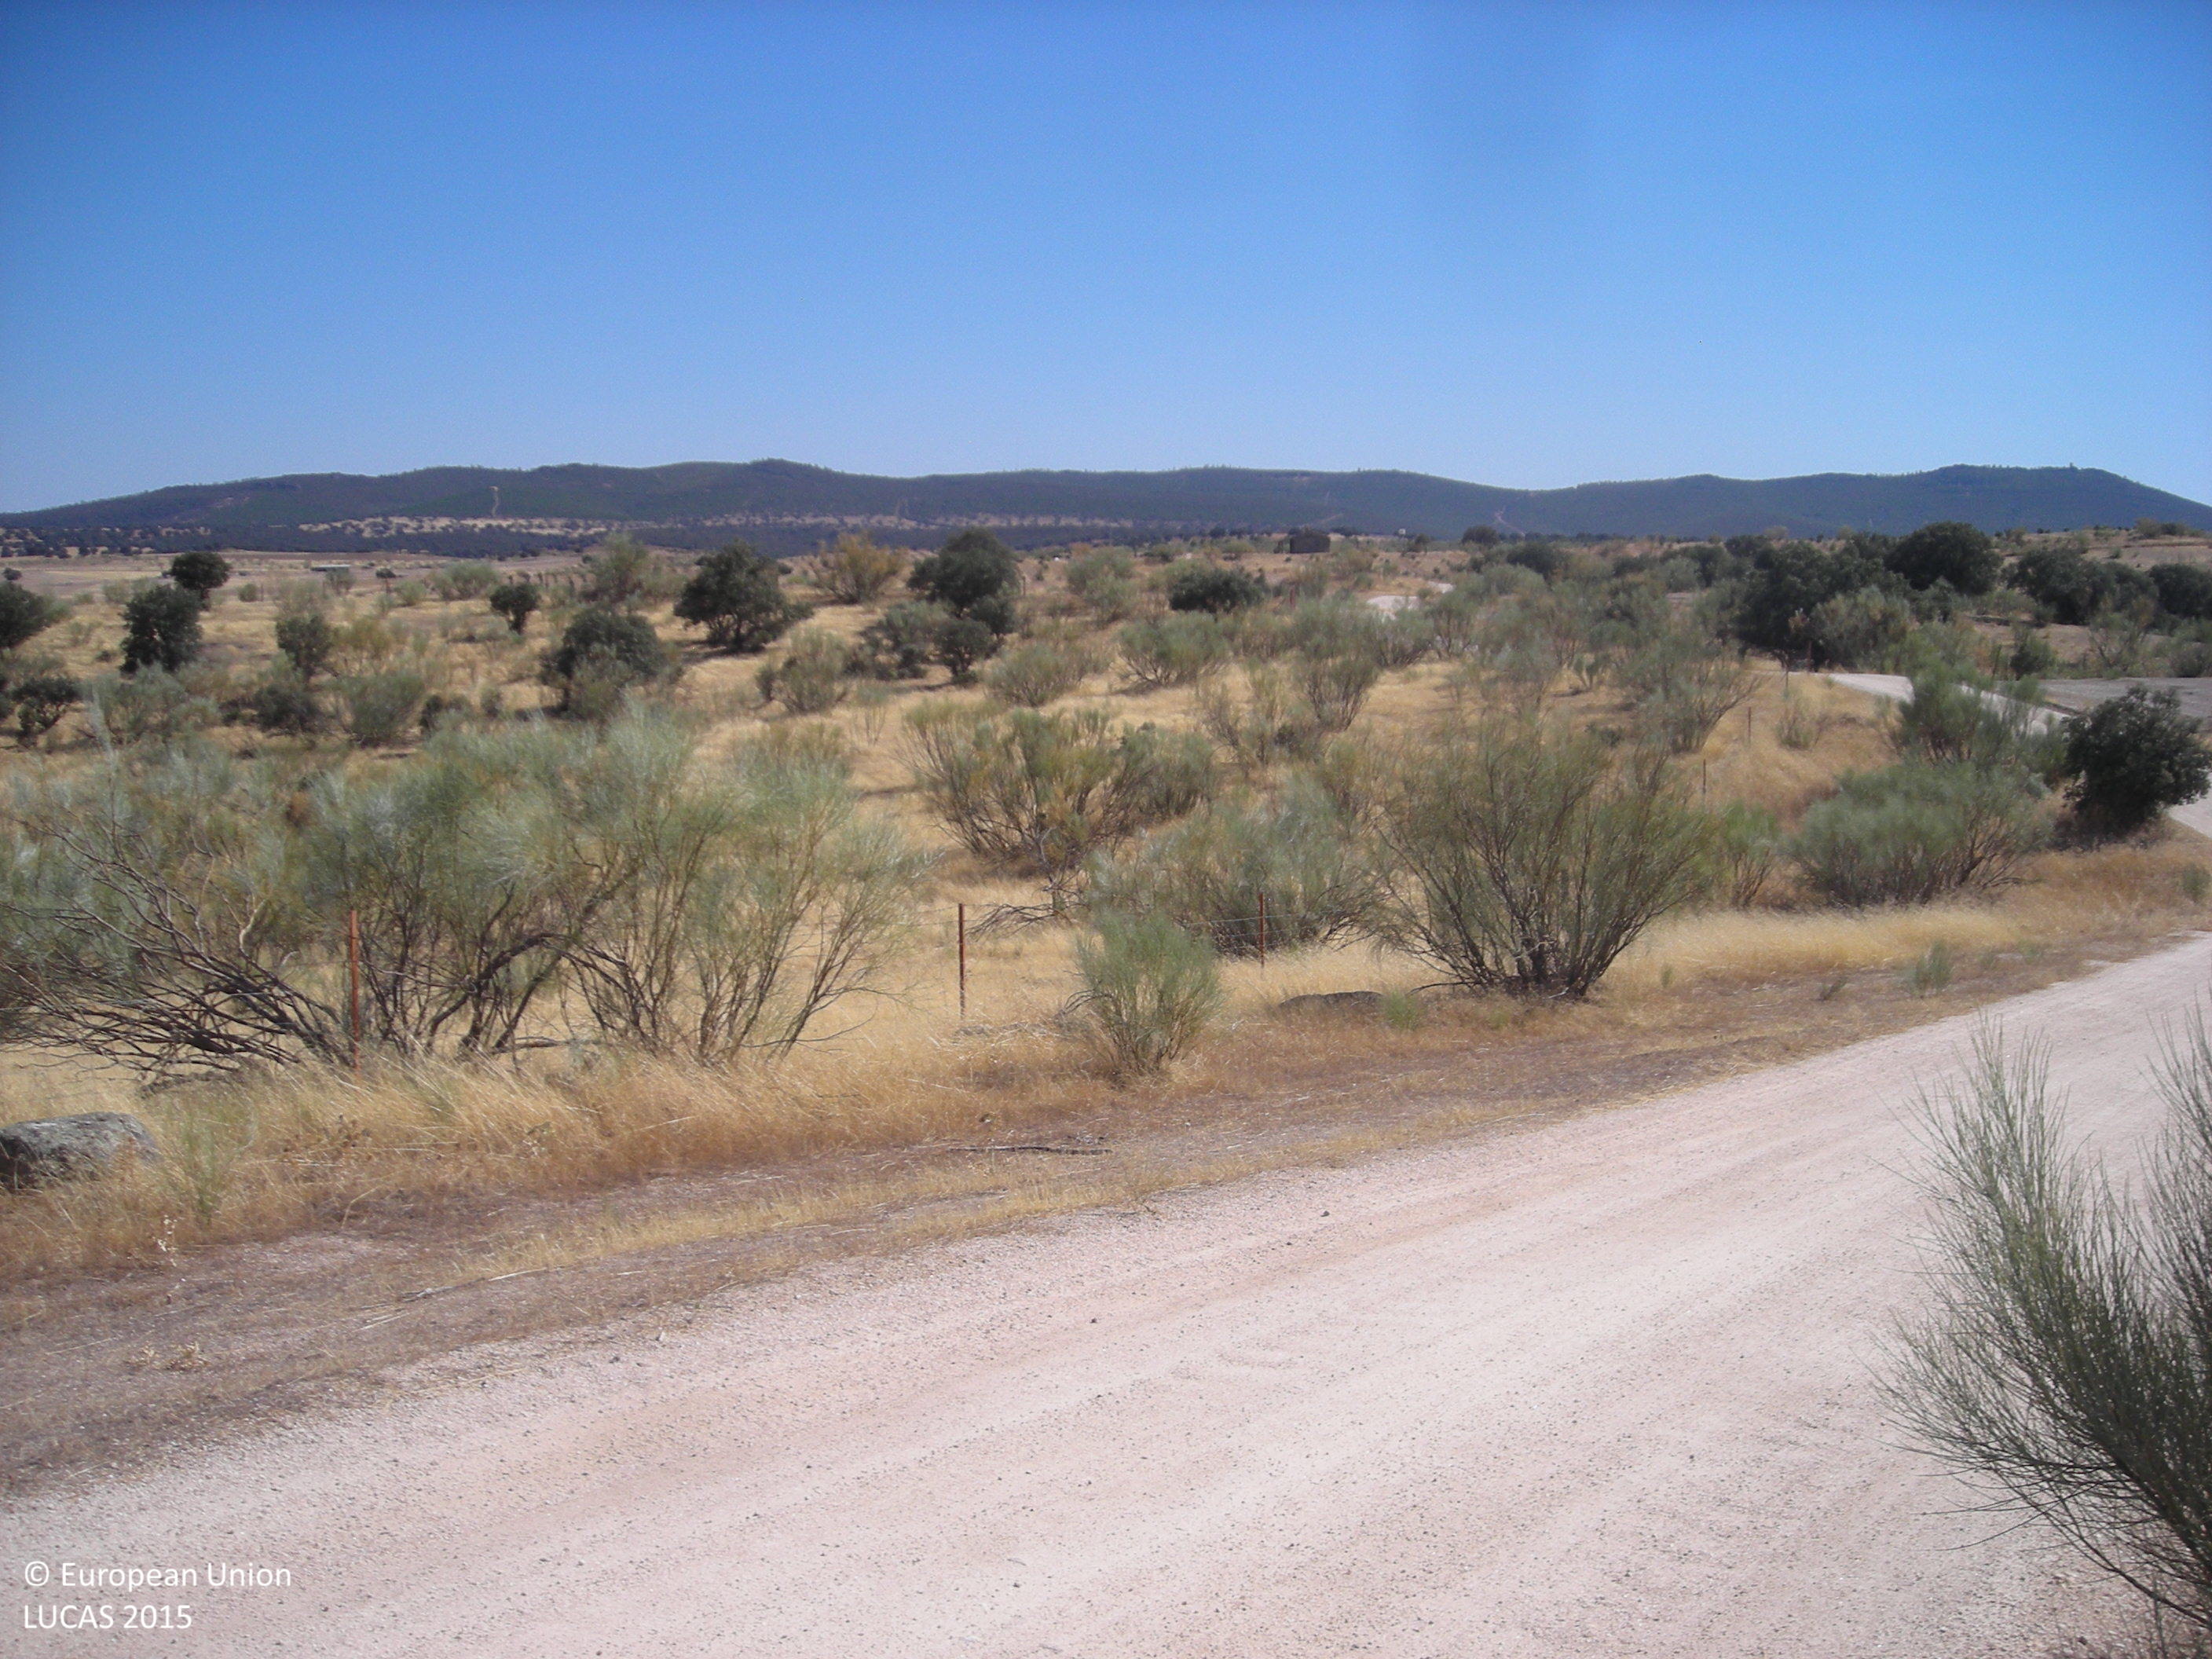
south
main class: Shrubland
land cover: Shrubland with sparse tree cover
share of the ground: > 75 %
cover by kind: shrubs 95 %, broadleaved forest trees 5 %
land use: Agriculture (excluding fallow land and kitchen gardens)
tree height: > 5 m
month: July
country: ES
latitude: 38.8496
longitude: -5.7974
